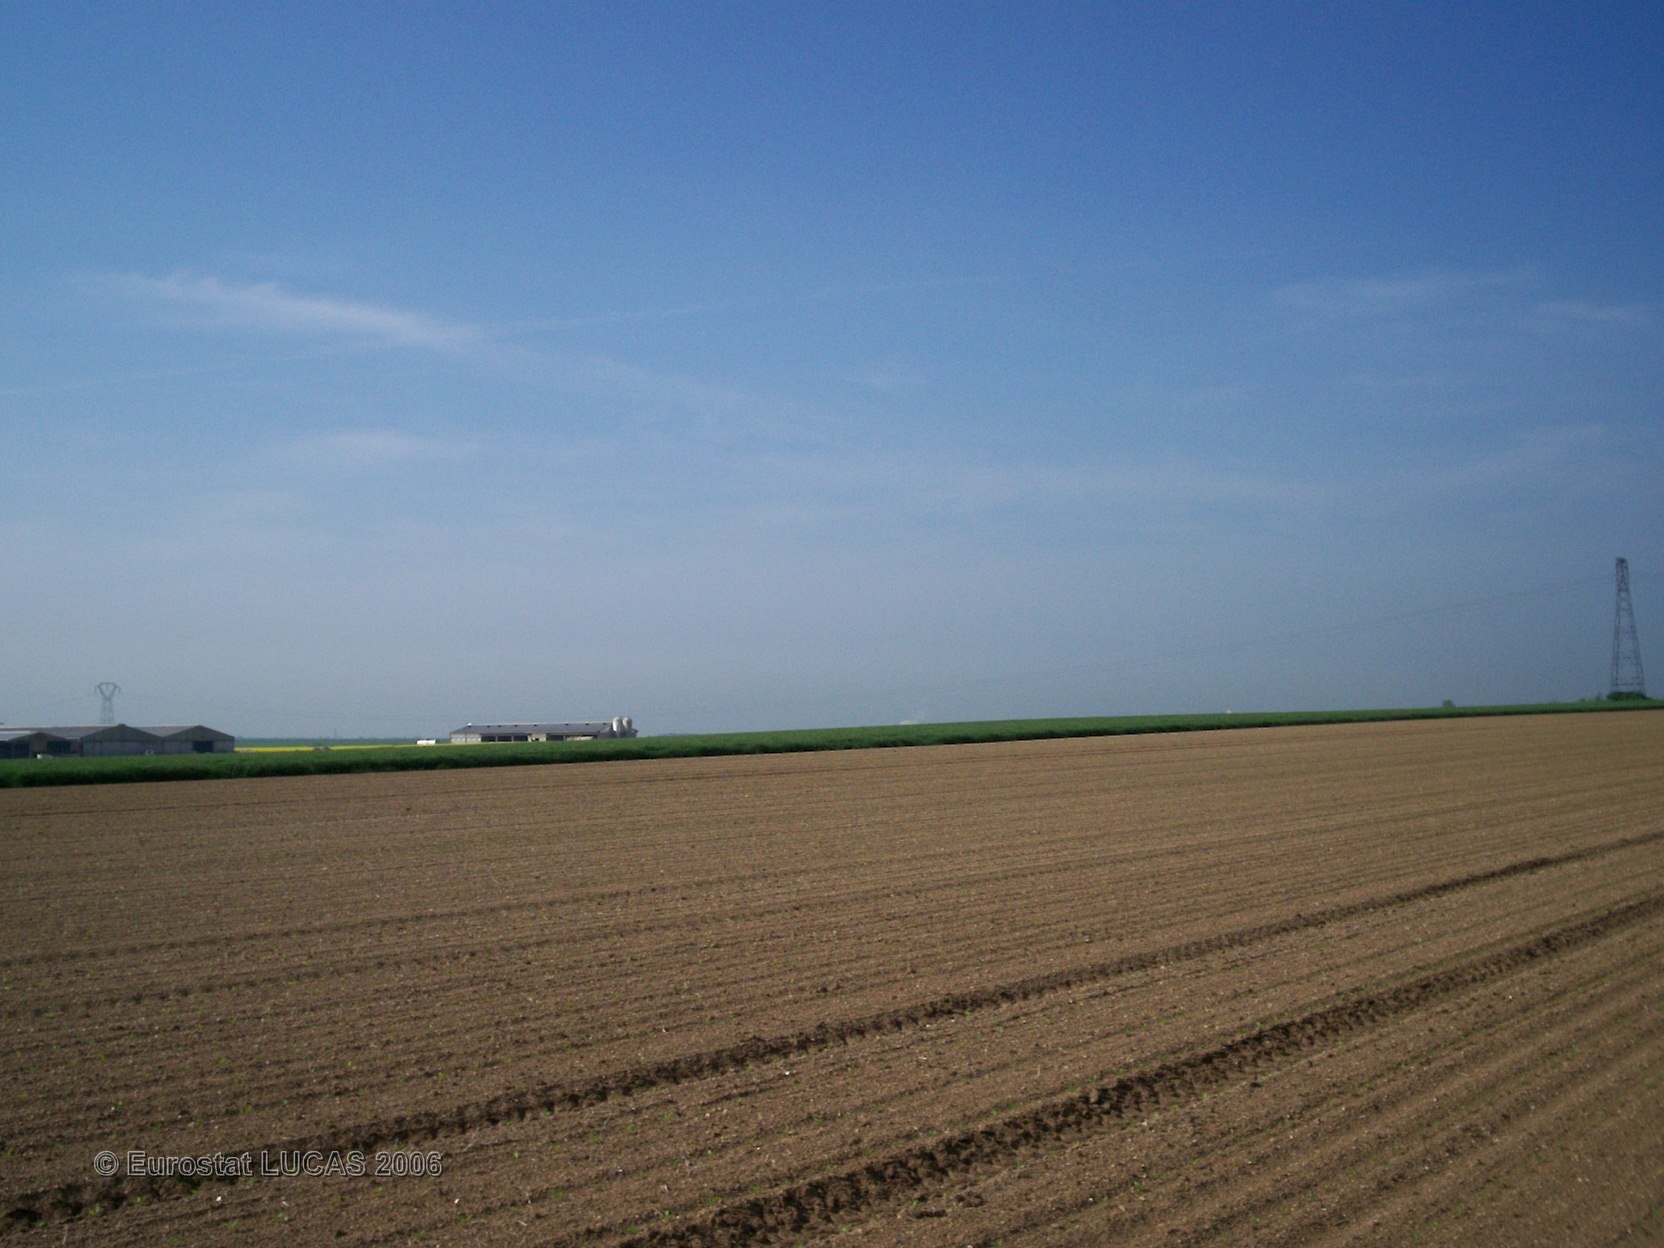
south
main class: Cropland
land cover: Sugar beet
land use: Agriculture (excluding fallow land and kitchen gardens)
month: May
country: FR
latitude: 49.0537
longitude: 4.3723
